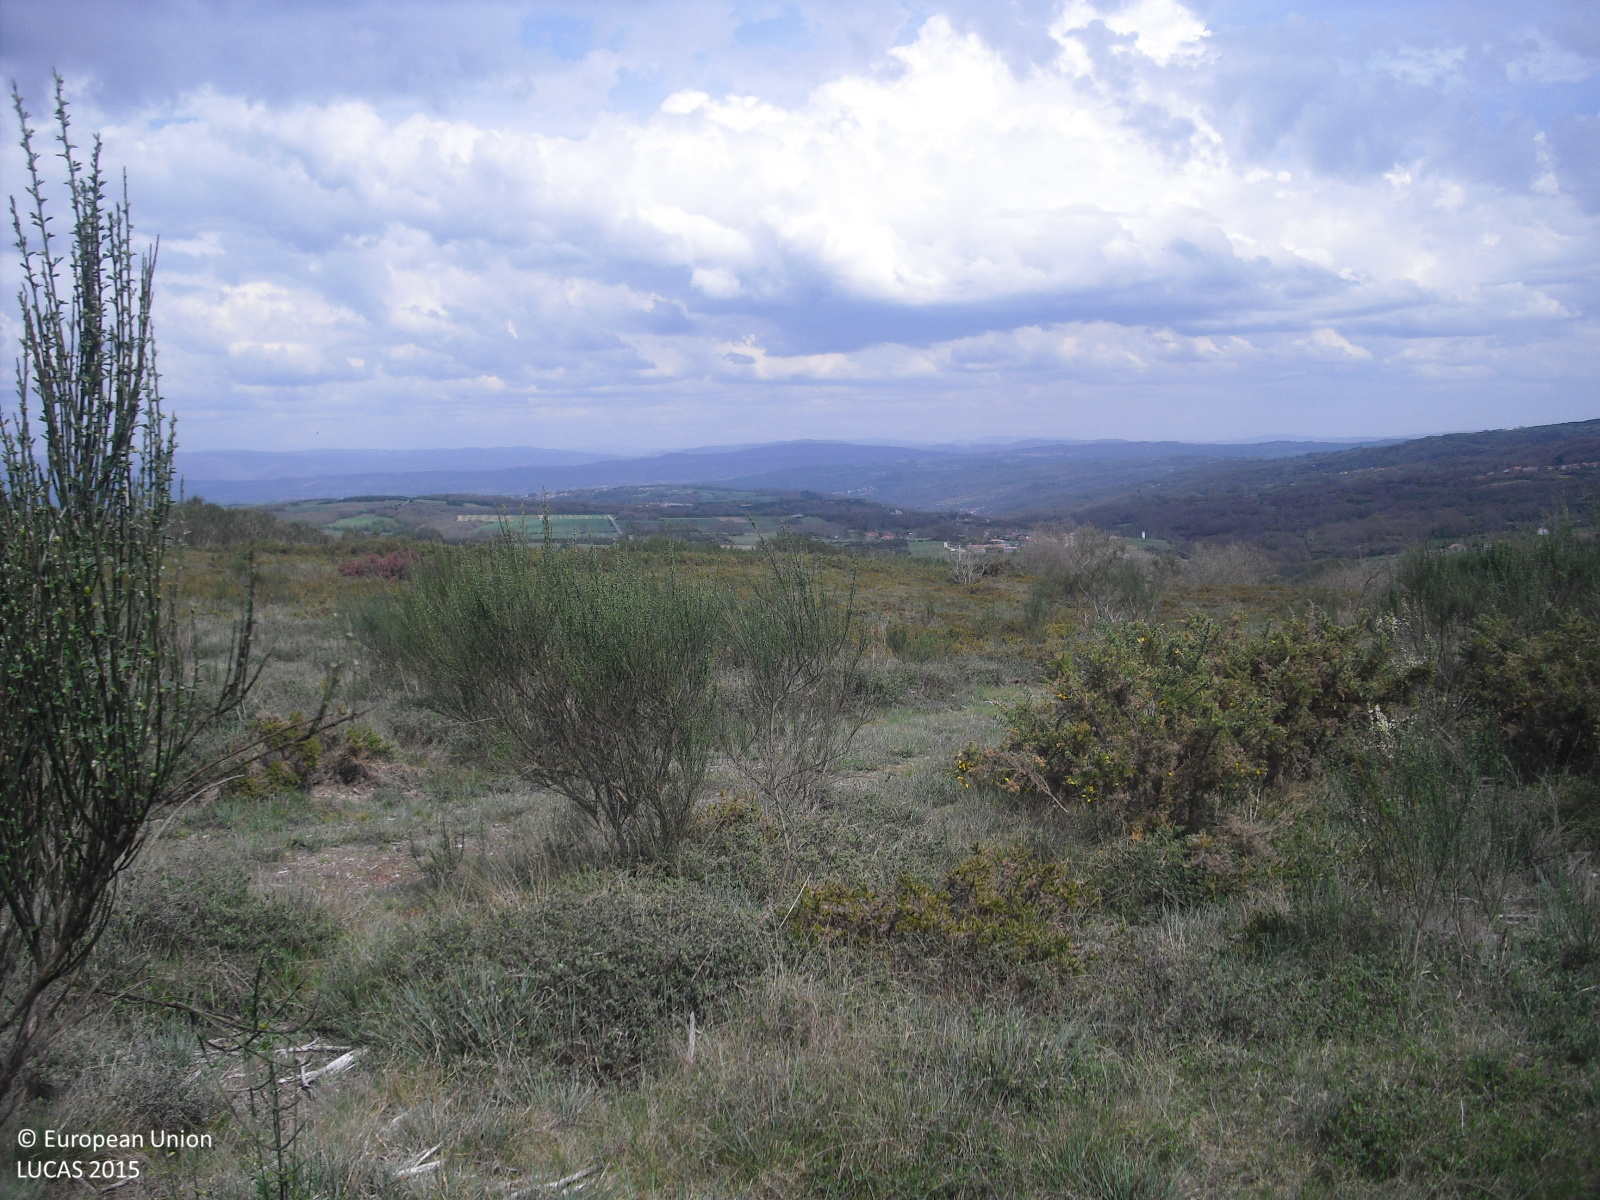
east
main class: Shrubland
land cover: Shrubland without tree cover
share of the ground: > 75 %
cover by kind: shrubs 90 %, herbaceous plants 10 %
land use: Semi-natural and natural areas not in use
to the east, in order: Shrubland without tree cover; Dry stone walls; Tracks; Shrubland without tree cover; Tracks; Shrubland without tree cover; Broadleaved woodland; Shrubland with sparse tree cover; Shrubland without tree cover; Tracks; Shrubland with sparse tree cover; Tracks; Shrubland without tree cover
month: April
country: ES
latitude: 41.9846
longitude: -7.8011
